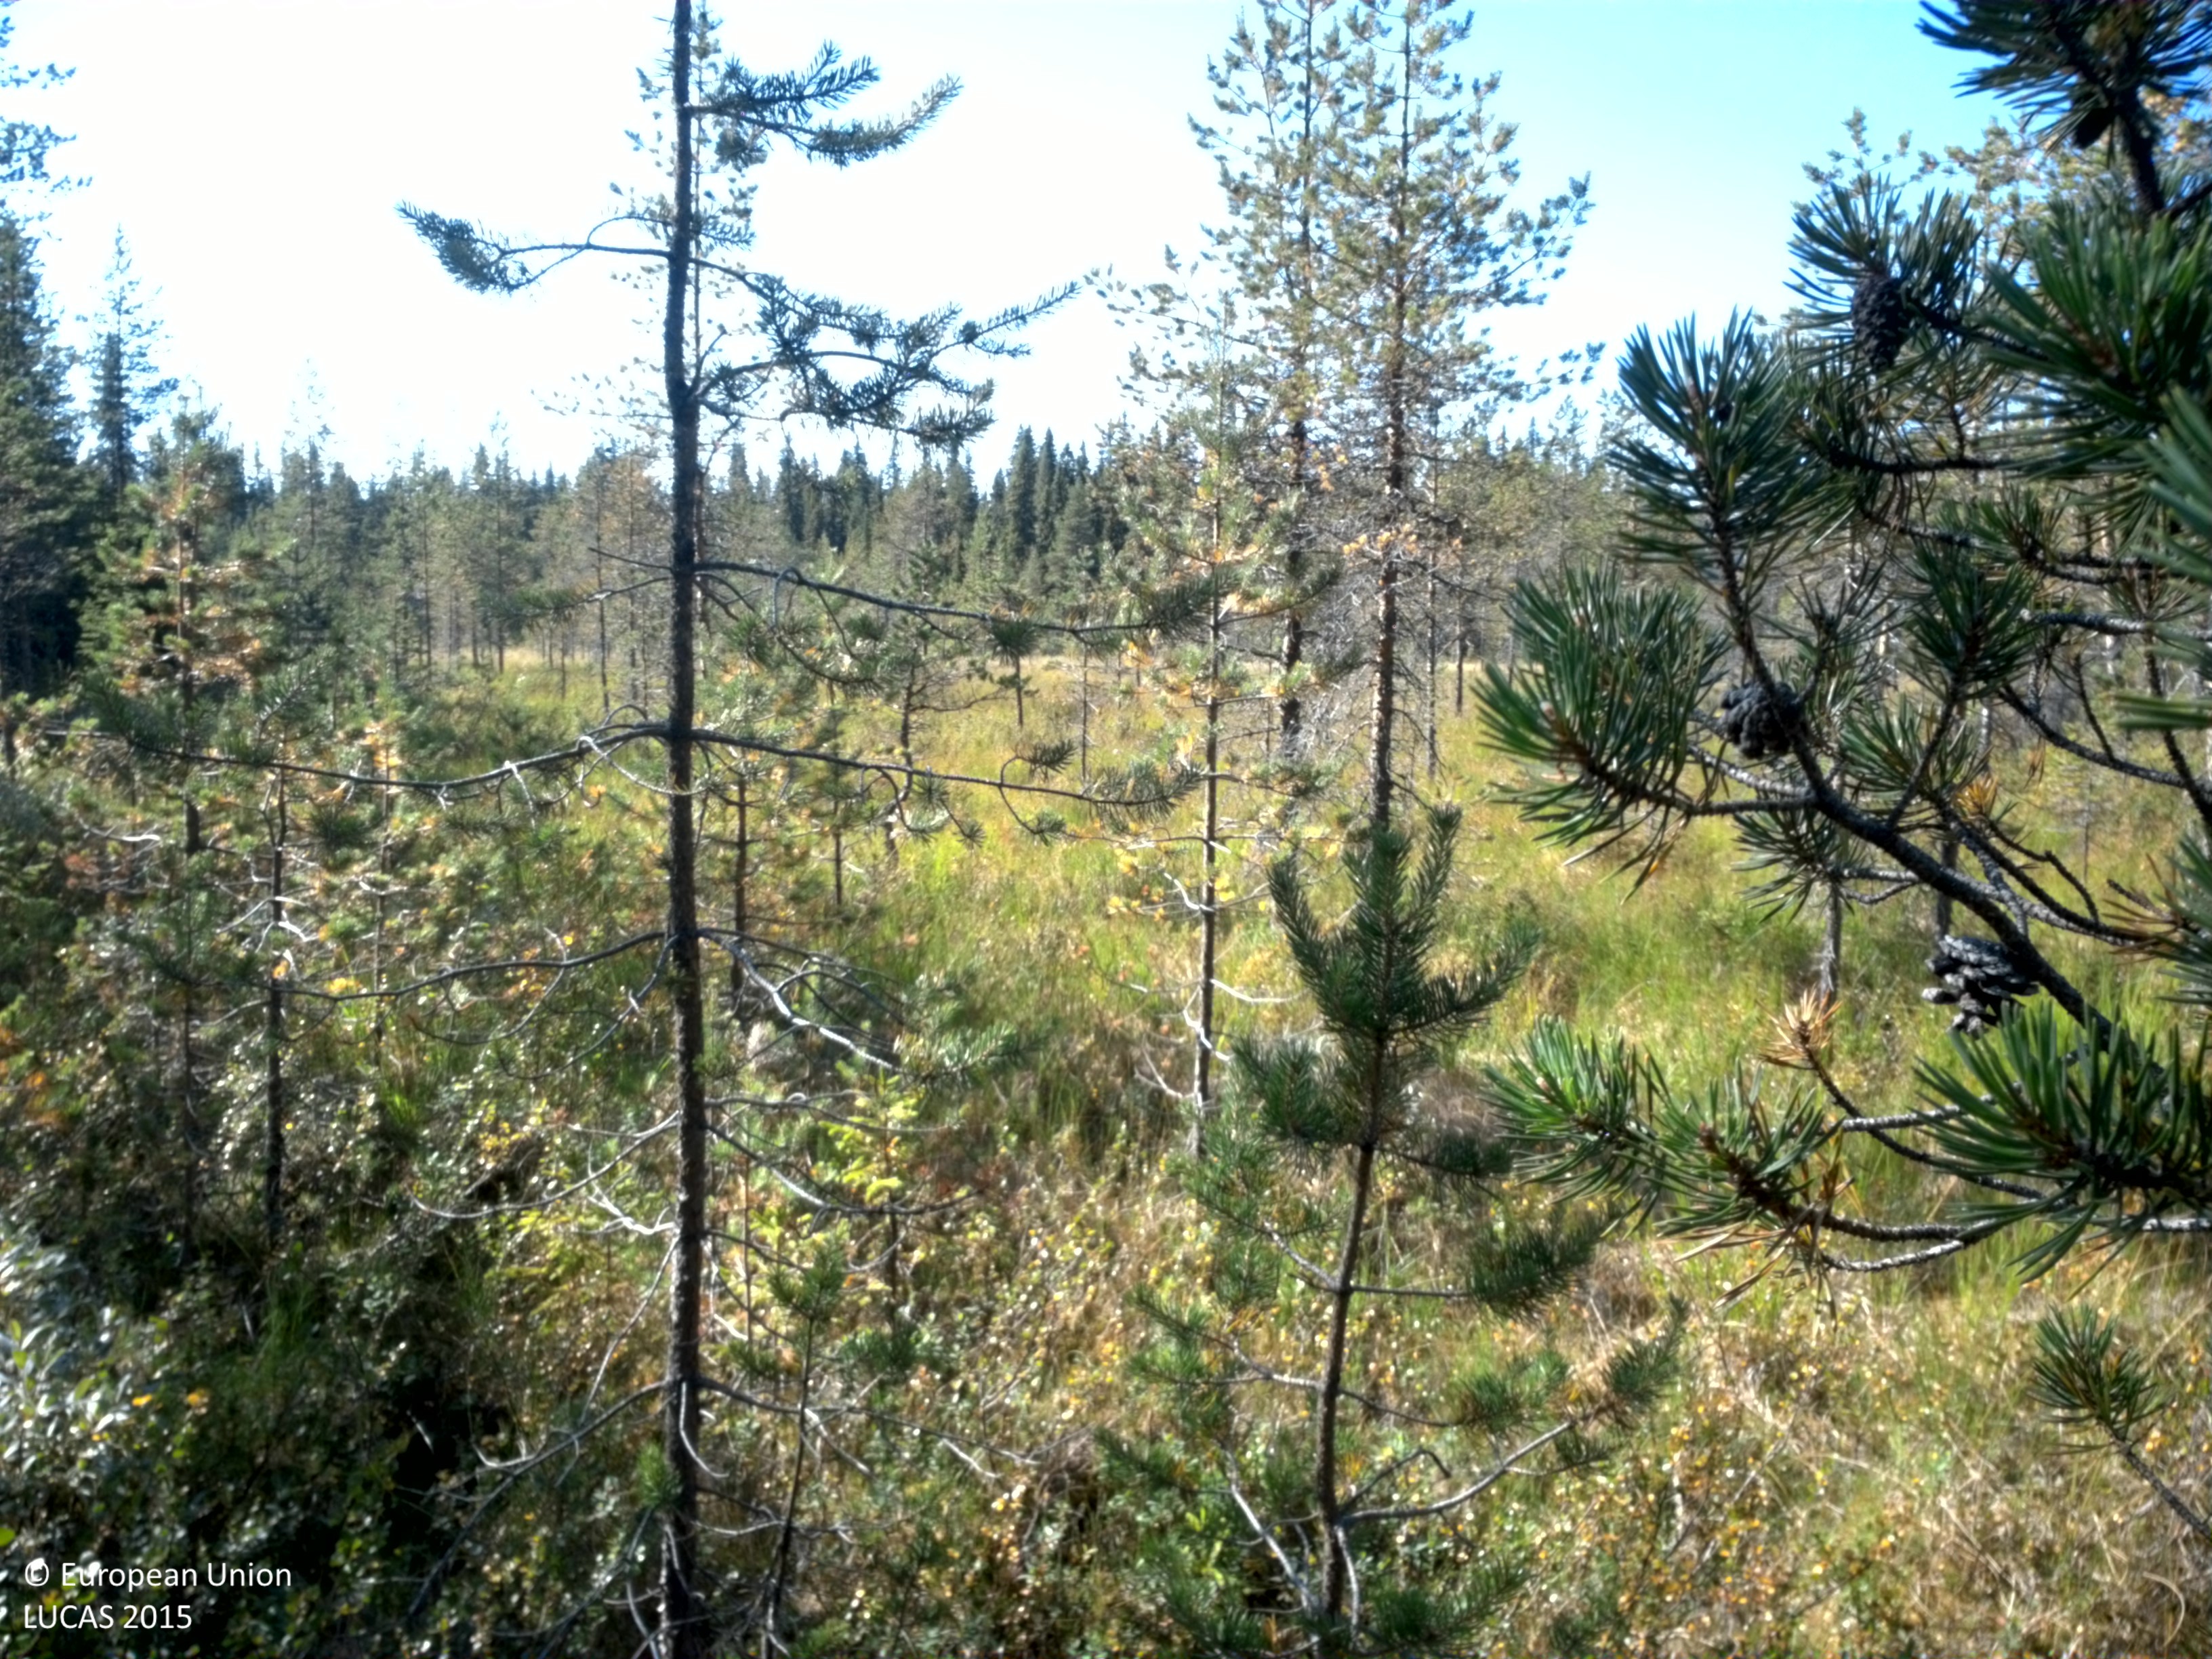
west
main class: Woodland
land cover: Pine dominated coniferous woodland
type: mire and swamp forests
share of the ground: 10 - 25 %
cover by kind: shrubs 45 %, coniferous forest trees 20 %, herbaceous plants 20 %, lichens and mosses 15 %
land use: Semi-natural and natural areas not in use
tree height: > 5 m
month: August
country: SE
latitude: 64.6483
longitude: 16.4350
